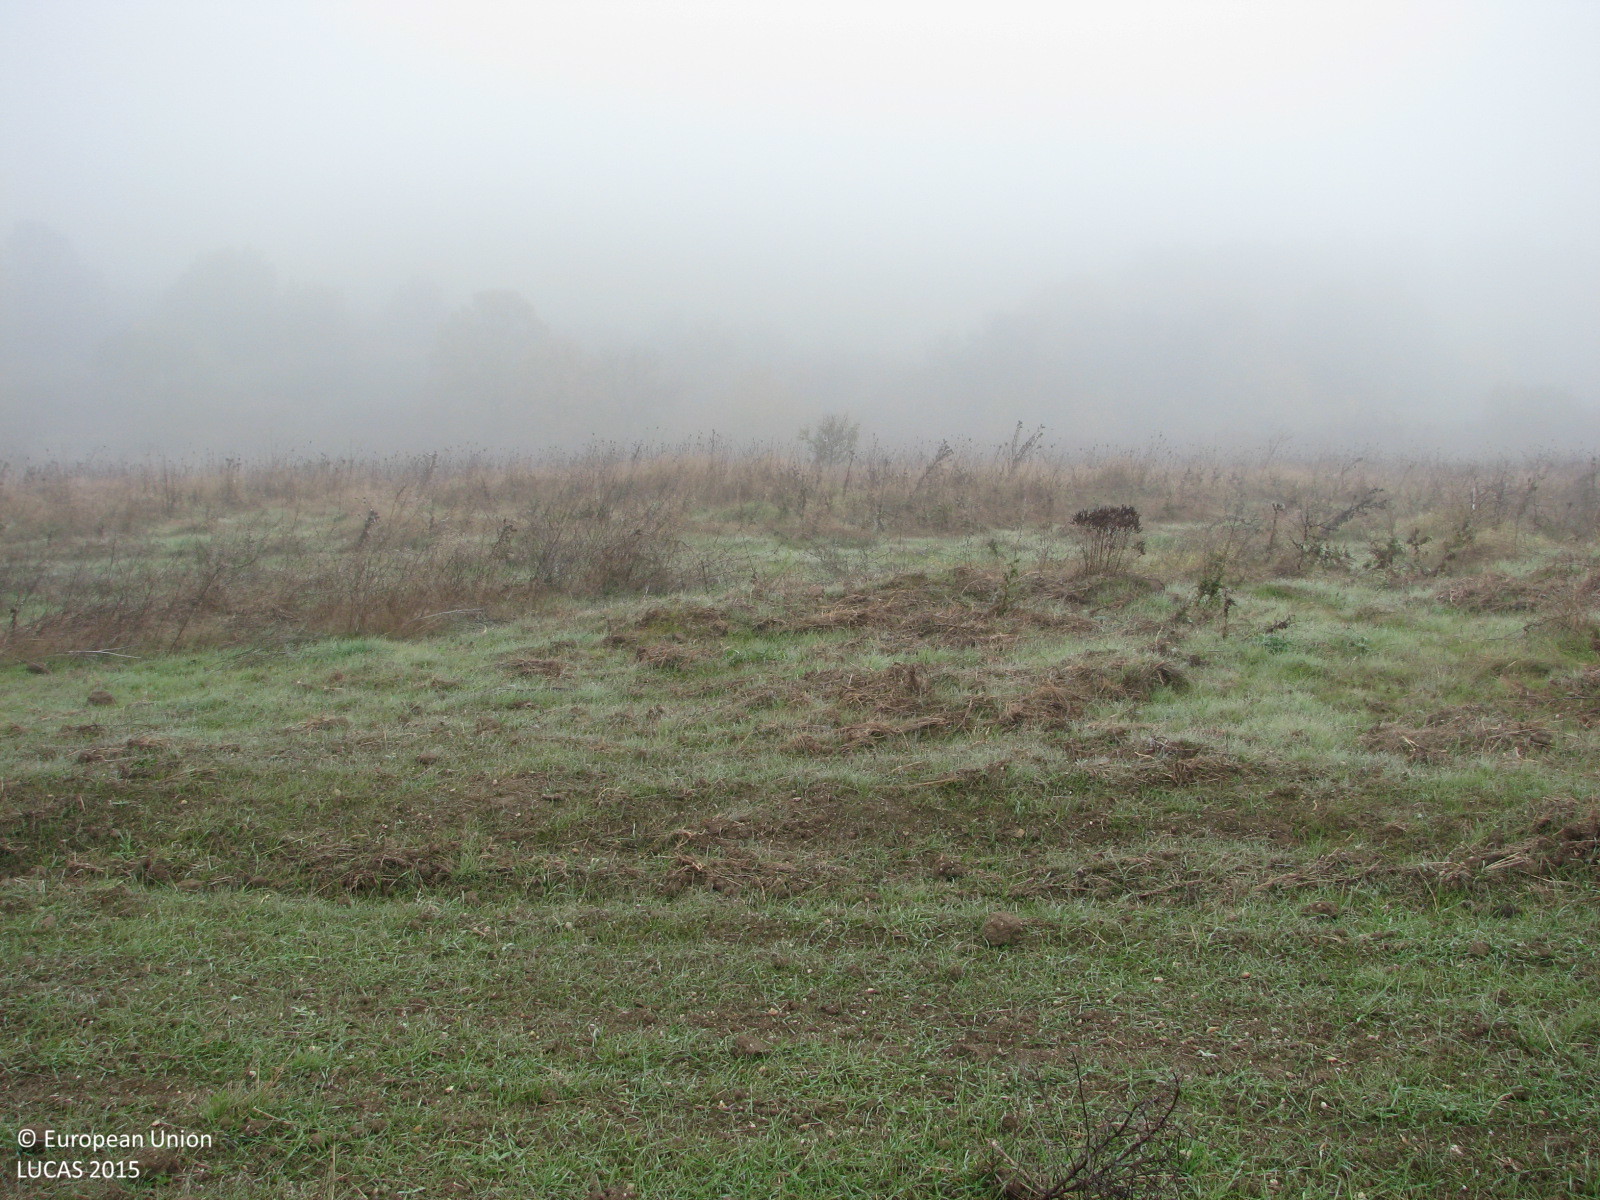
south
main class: Grassland
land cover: Spontaneously vegetated surfaces
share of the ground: > 75 %
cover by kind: herbaceous plants 100 %
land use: Agriculture (excluding fallow land and kitchen gardens)
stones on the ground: < 10 %
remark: Harvested field
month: November
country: BG
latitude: 42.1075
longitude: 26.6709
